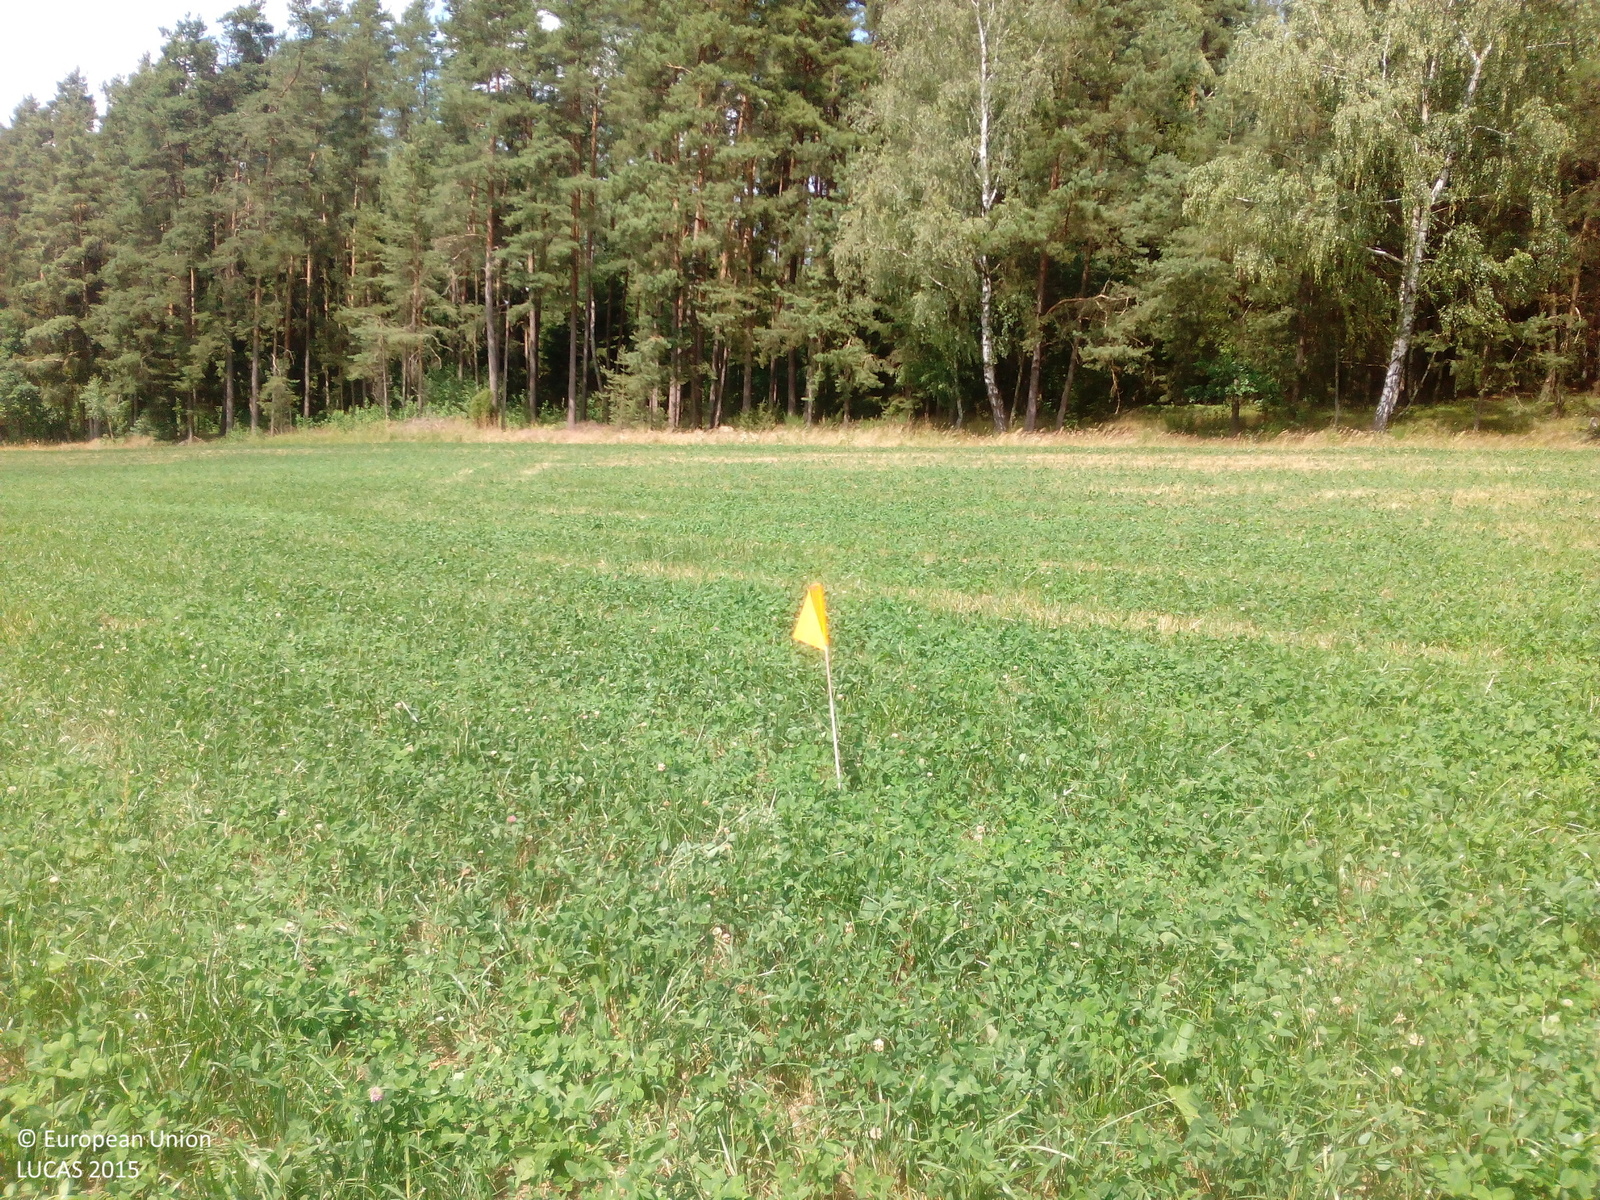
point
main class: Cropland
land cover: Other leguminous and mixtures for fodder
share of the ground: > 75 %
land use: Agriculture (excluding fallow land and kitchen gardens)
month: July
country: DE
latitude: 49.5329
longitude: 12.2241
